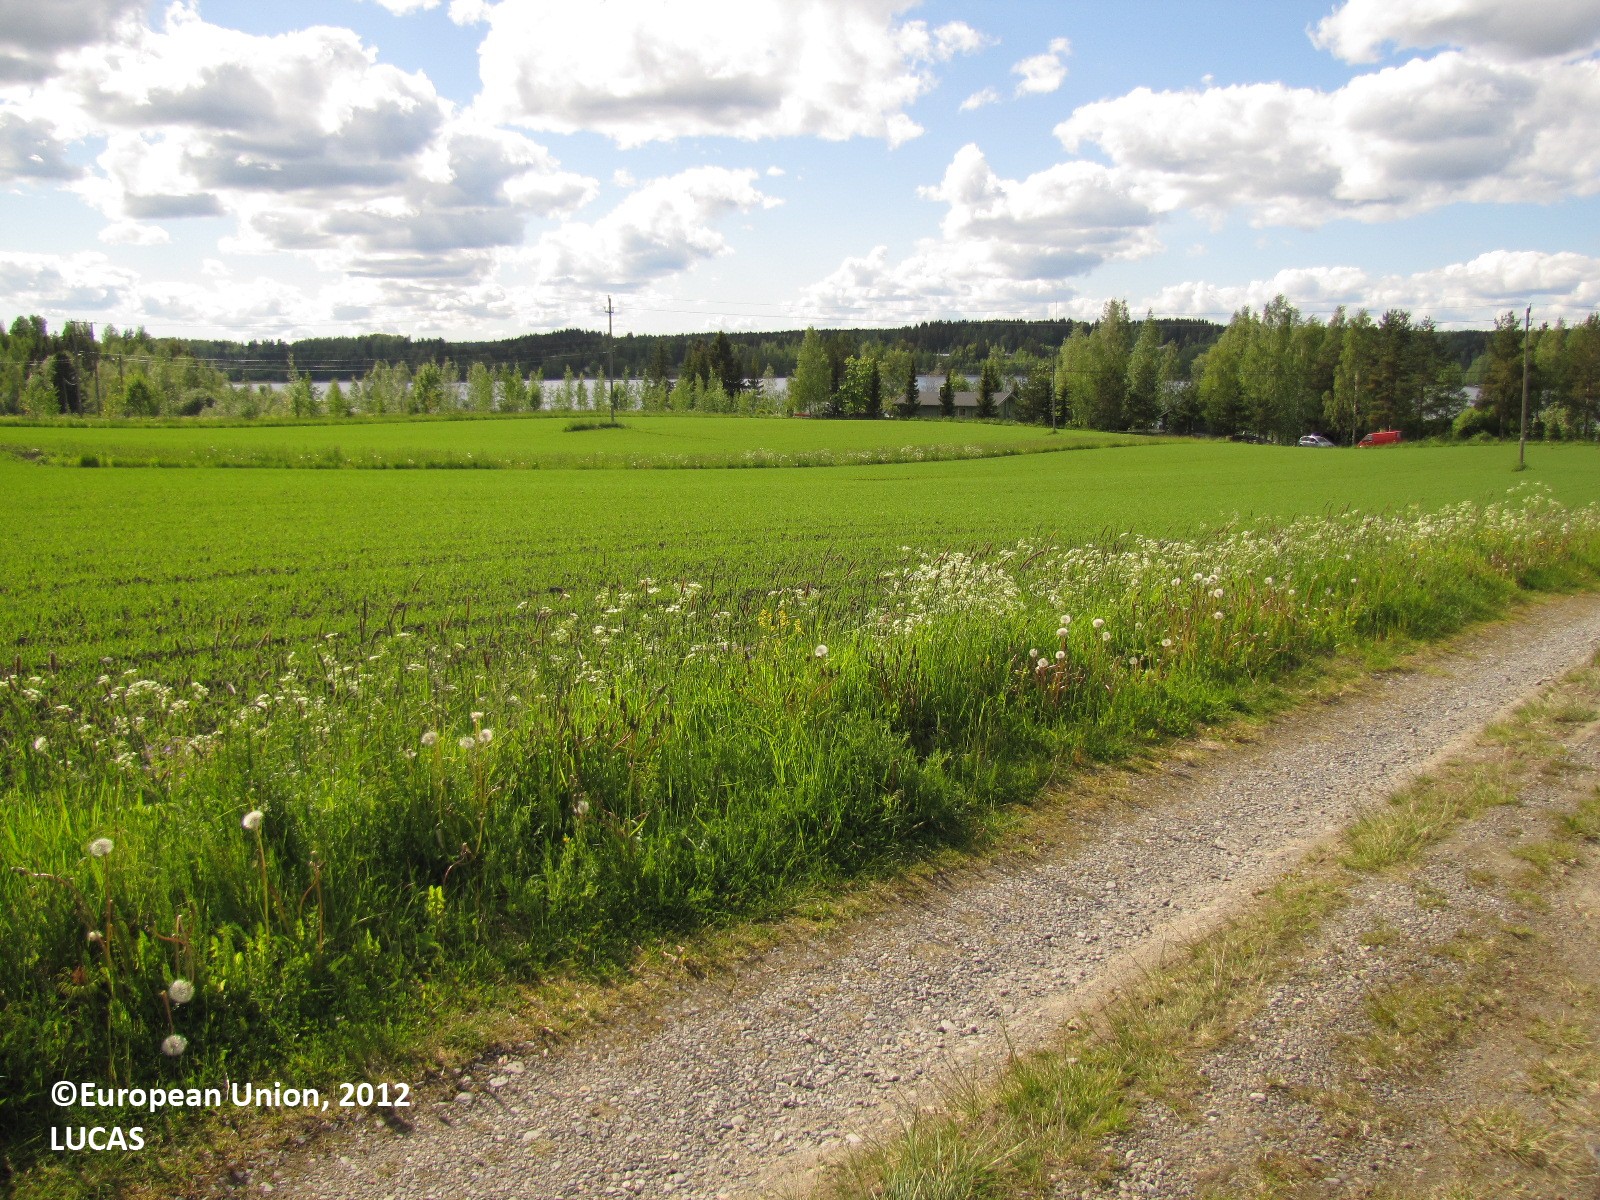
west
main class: Cropland
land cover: Common wheat
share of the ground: 50 - 75 %
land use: Agriculture (excluding fallow land and kitchen gardens)
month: June
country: FI
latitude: 61.4357
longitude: 23.0649
